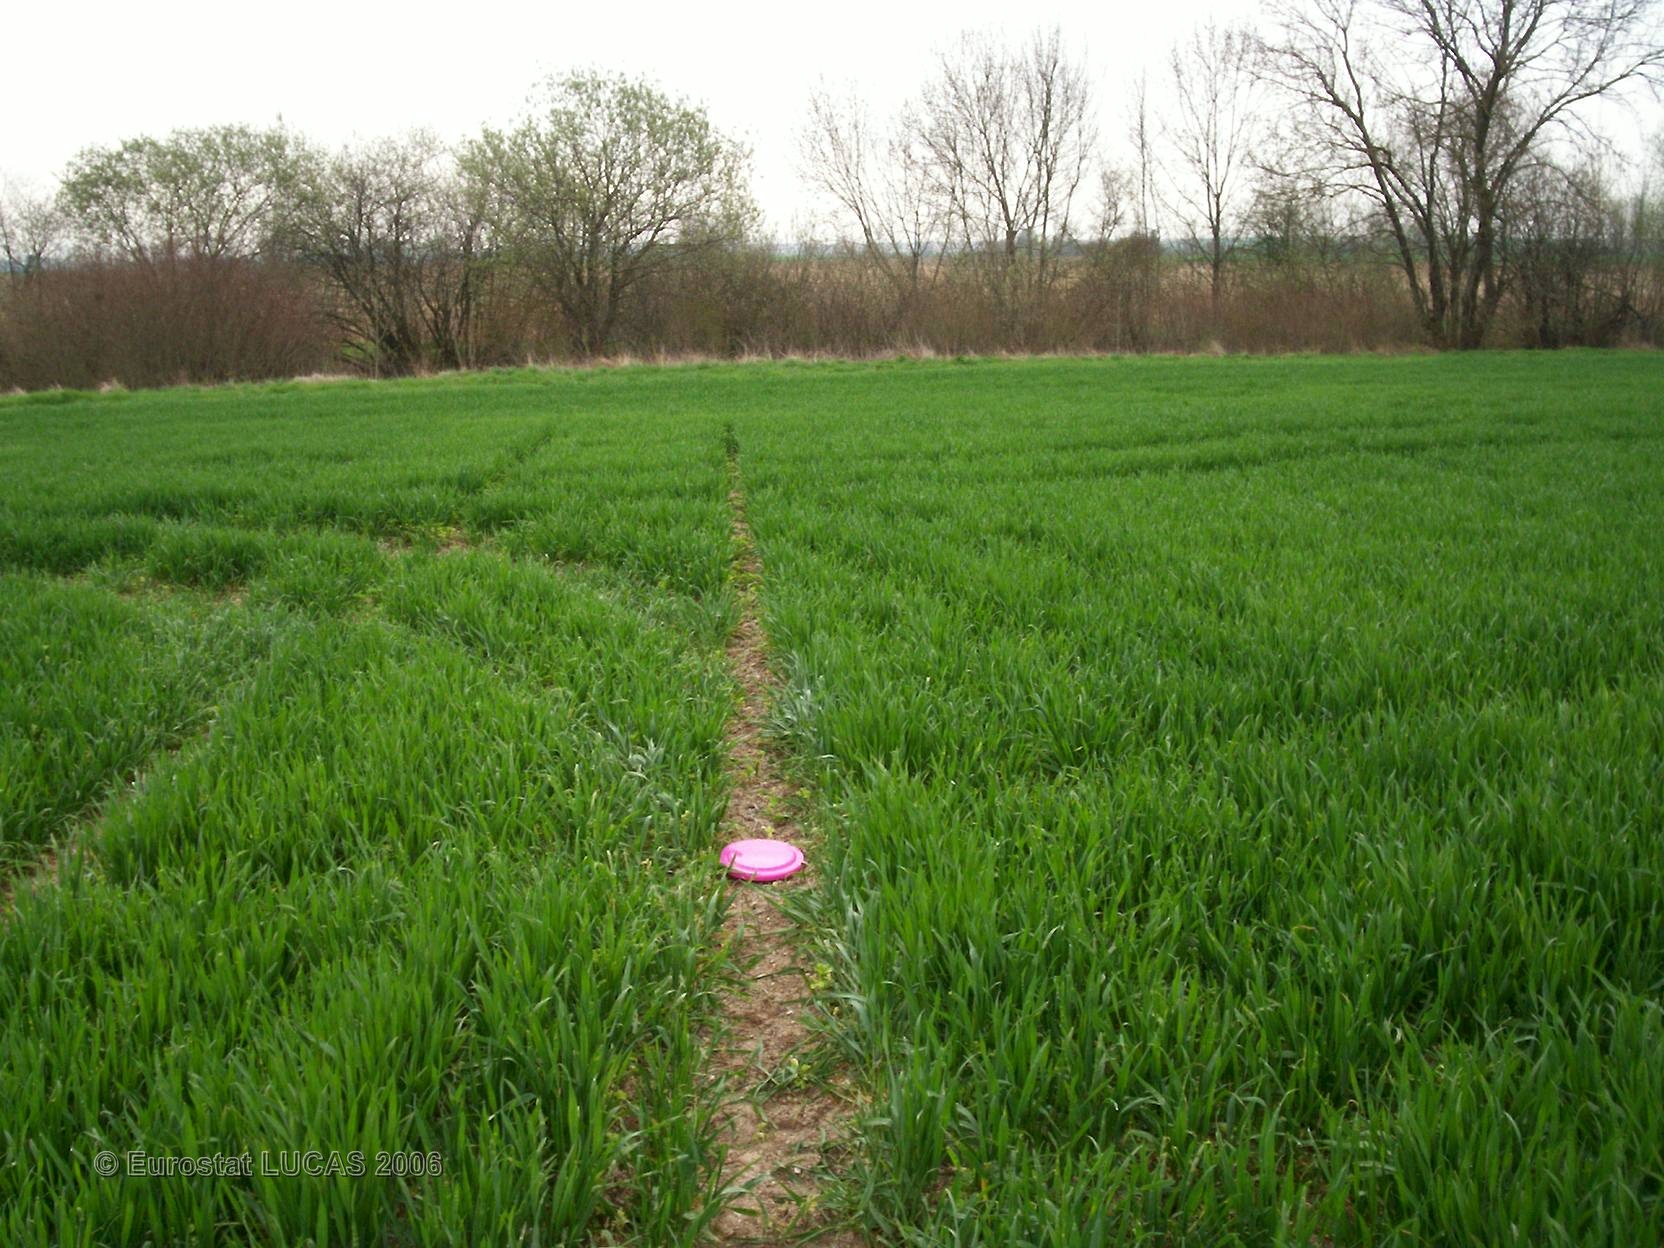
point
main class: Cropland
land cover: Common wheat
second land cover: Lucerne
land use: Agriculture (excluding fallow land and kitchen gardens)
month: April
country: FR
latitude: 48.6531
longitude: 3.9547
